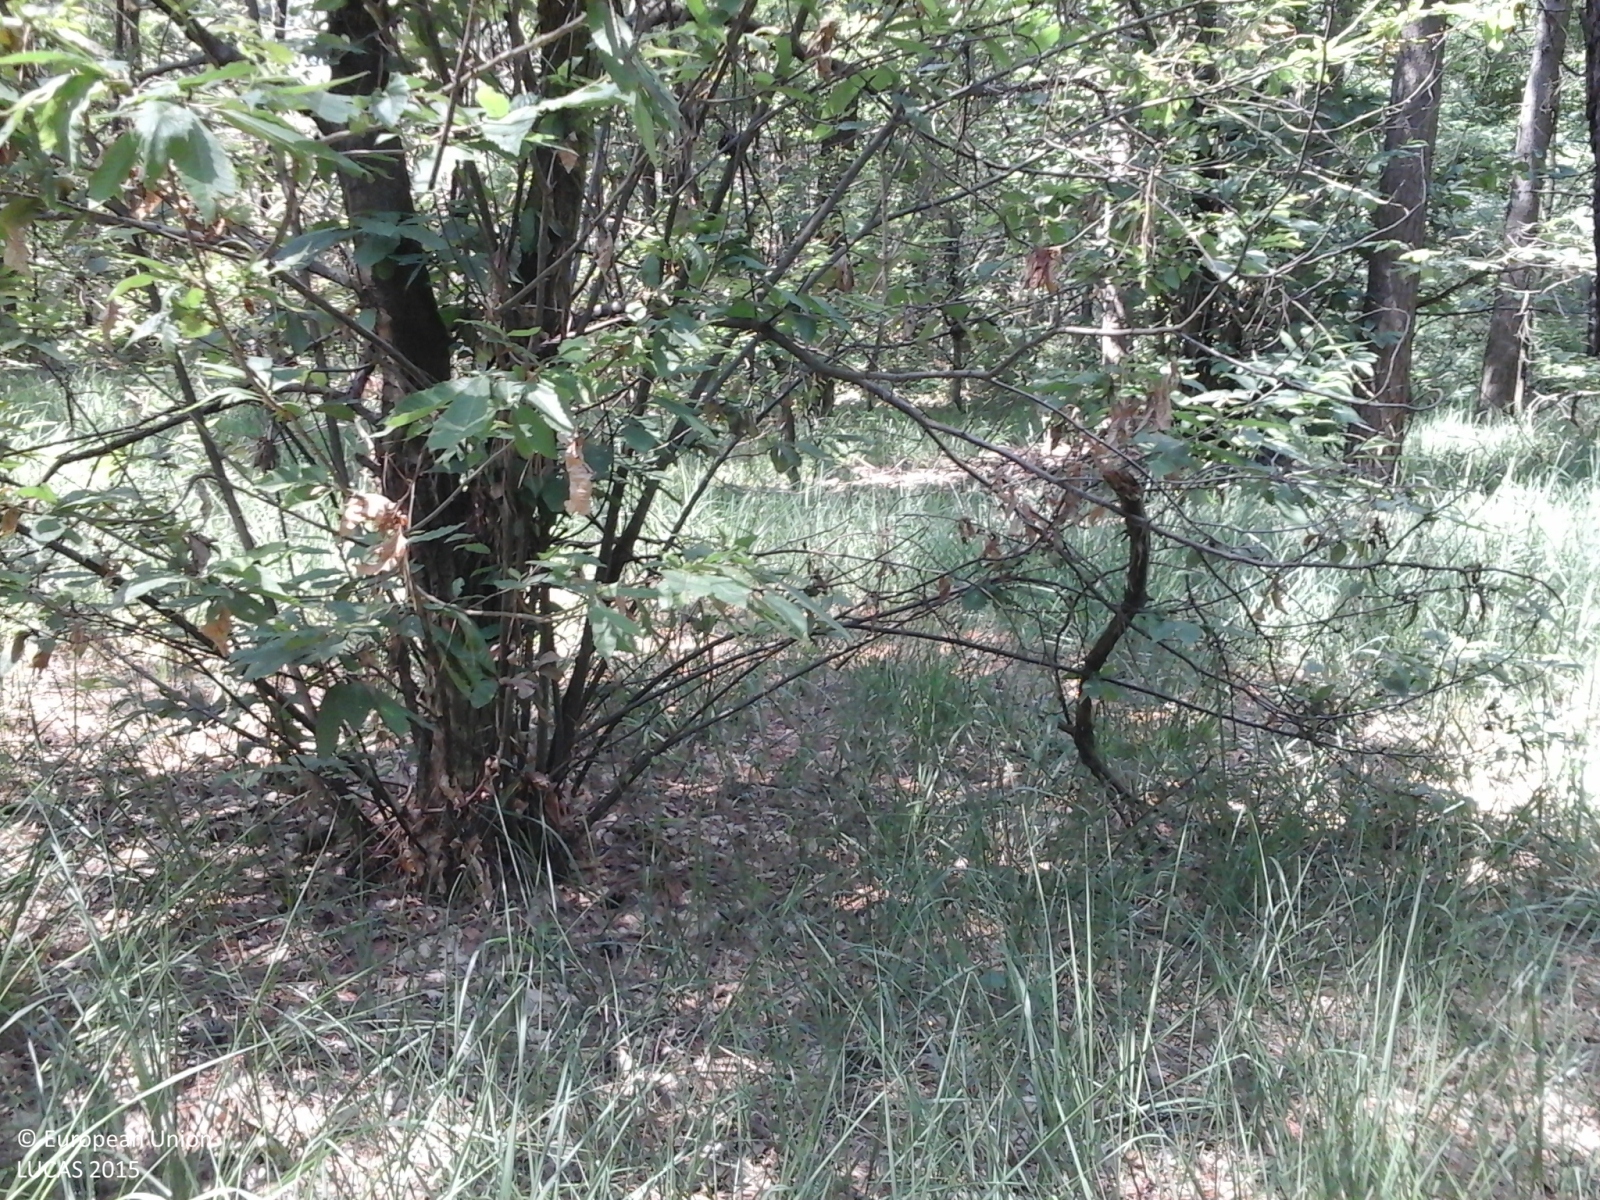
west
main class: Woodland
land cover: Pine dominated mixed woodland
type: thermophilous deciduous forest
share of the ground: > 75 %
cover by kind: coniferous forest trees 75 %, broadleaved forest trees 25 %
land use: Forestry
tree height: > 5 m
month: June
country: IT
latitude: 45.6587
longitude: 8.7059
